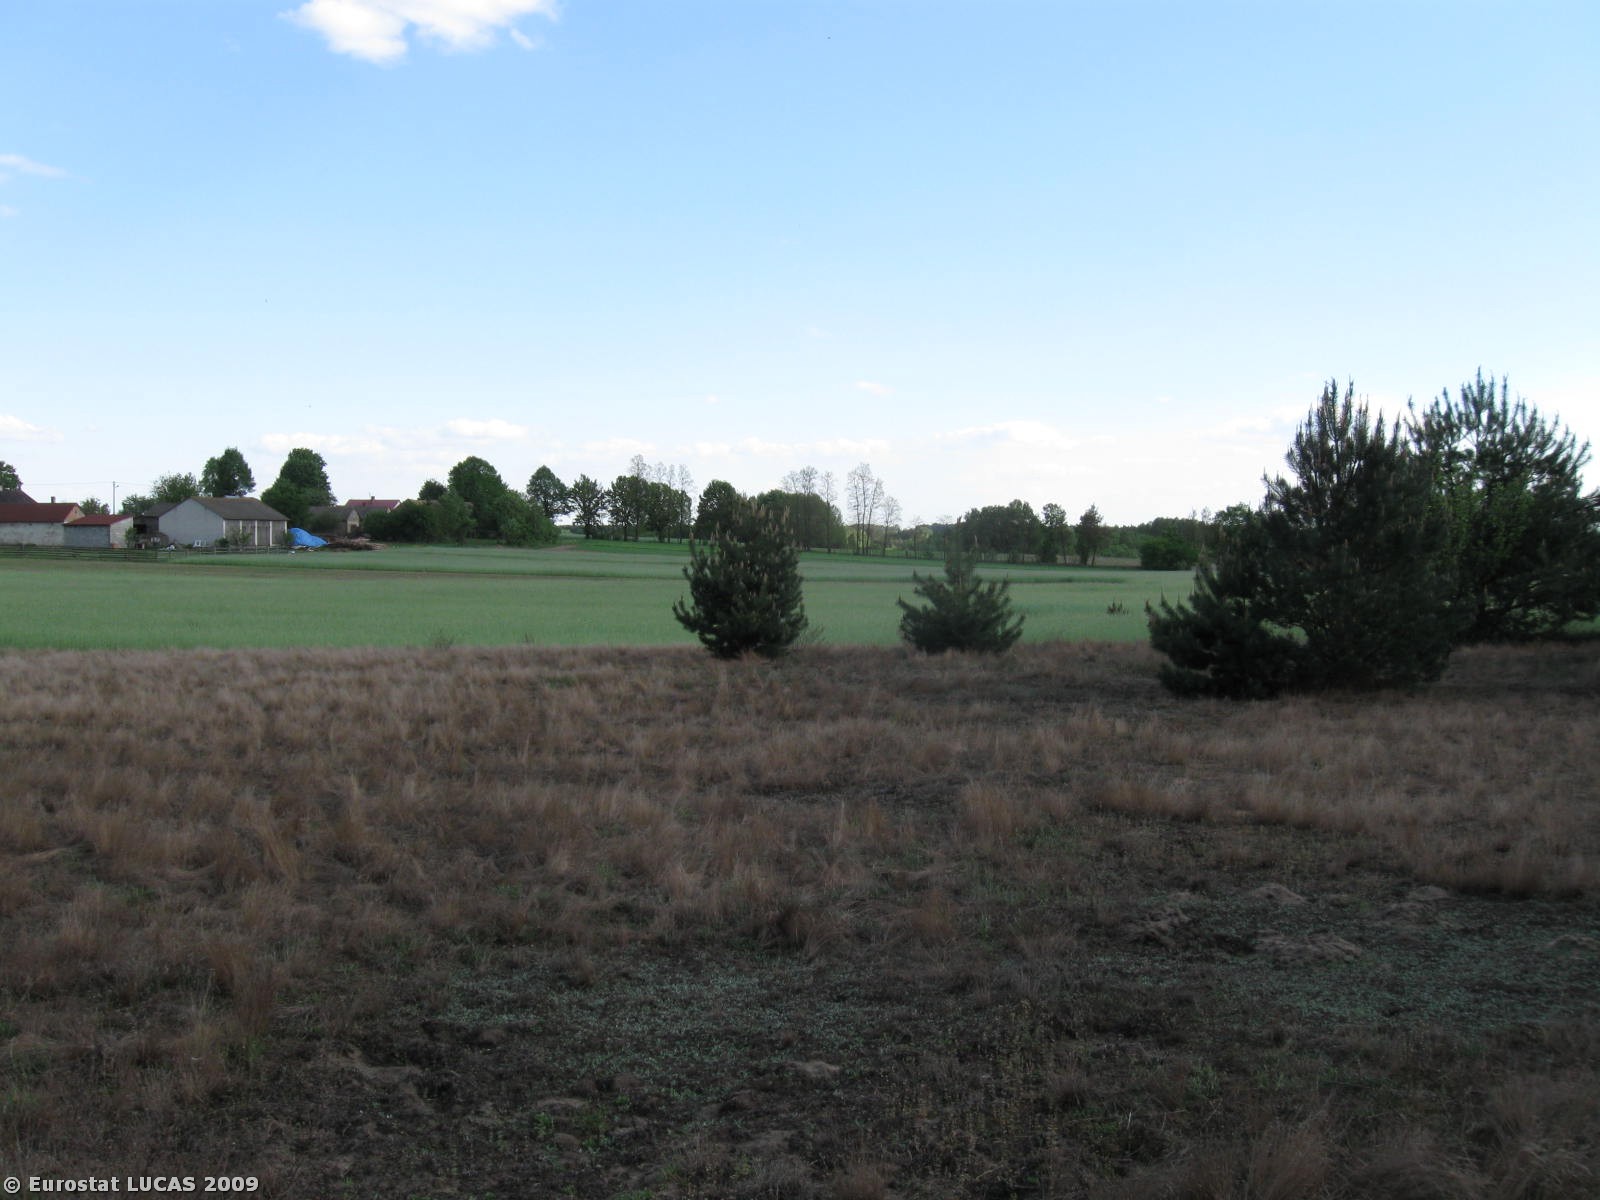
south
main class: Grassland
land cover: Grassland with sparse tree/shrub cover
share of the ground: > 75 %
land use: Unused
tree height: < 5 m
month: May
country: PL
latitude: 51.3220
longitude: 19.9768
